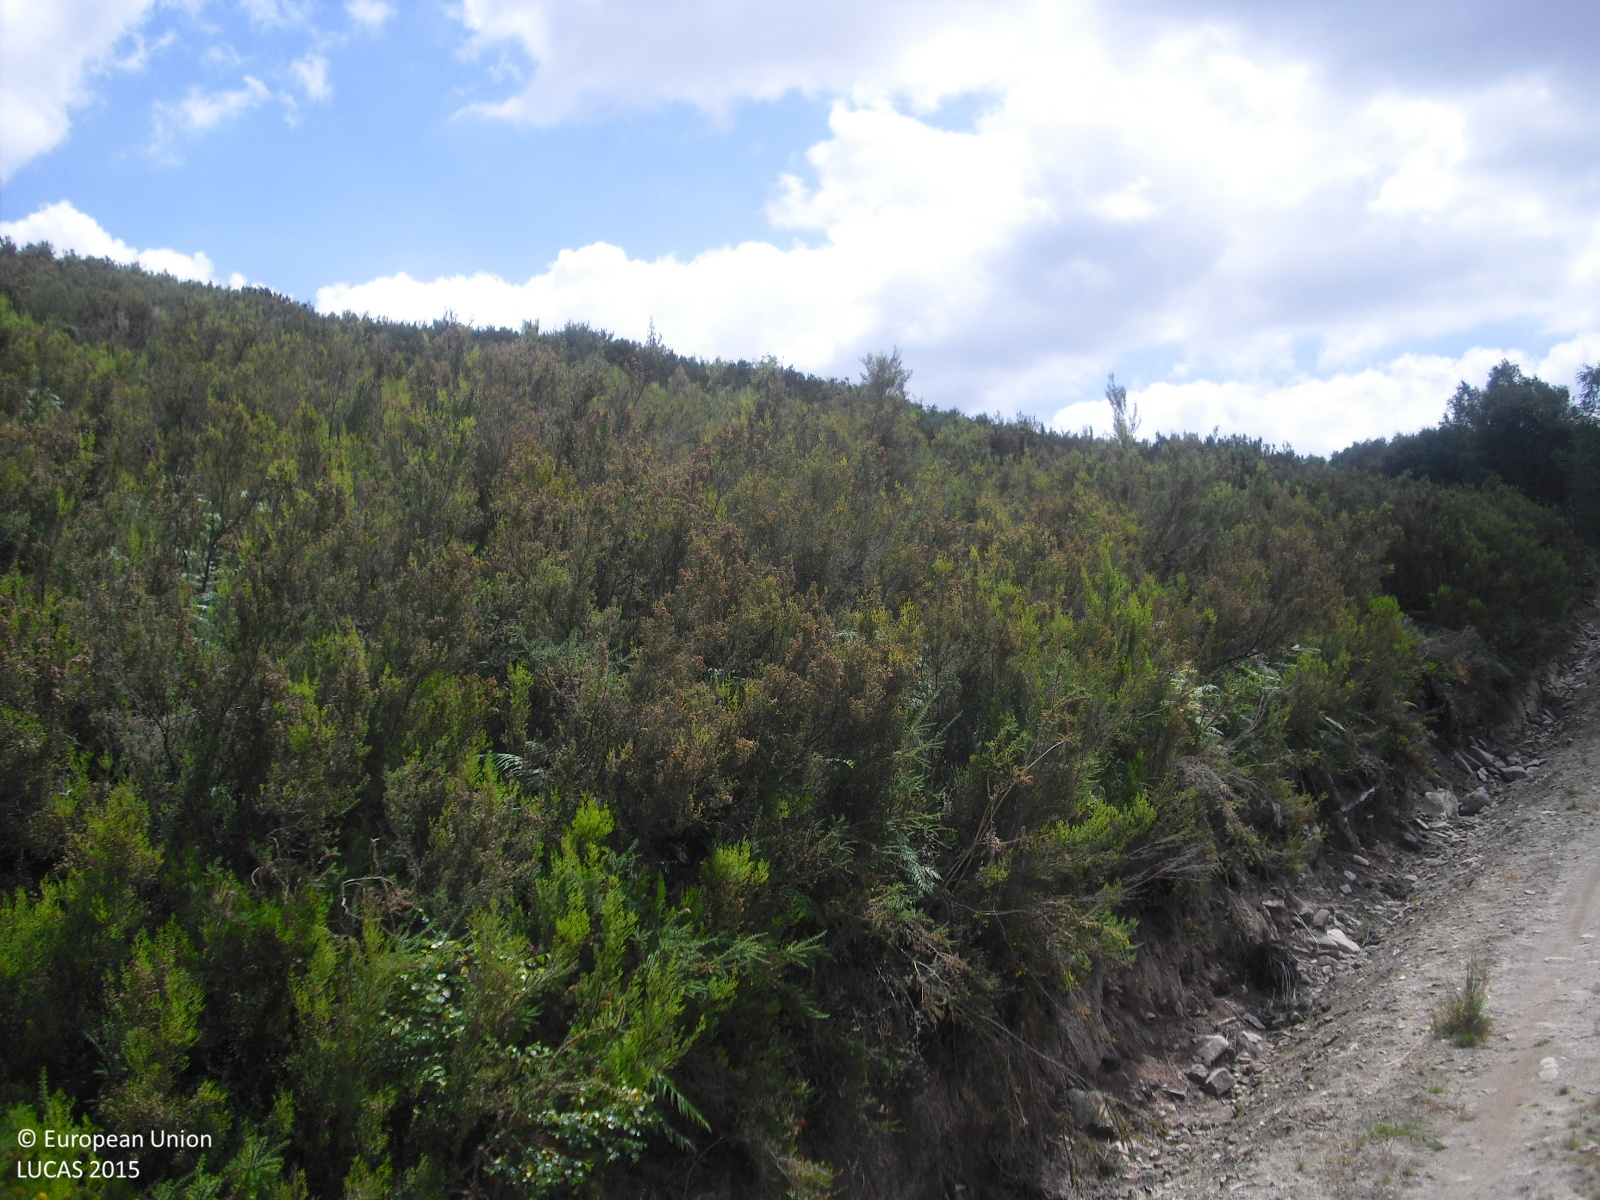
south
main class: Shrubland
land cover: Shrubland without tree cover
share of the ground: > 75 %
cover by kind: shrubs 100 %
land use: Semi-natural and natural areas not in use
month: July
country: ES
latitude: 42.3944
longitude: -7.6751
